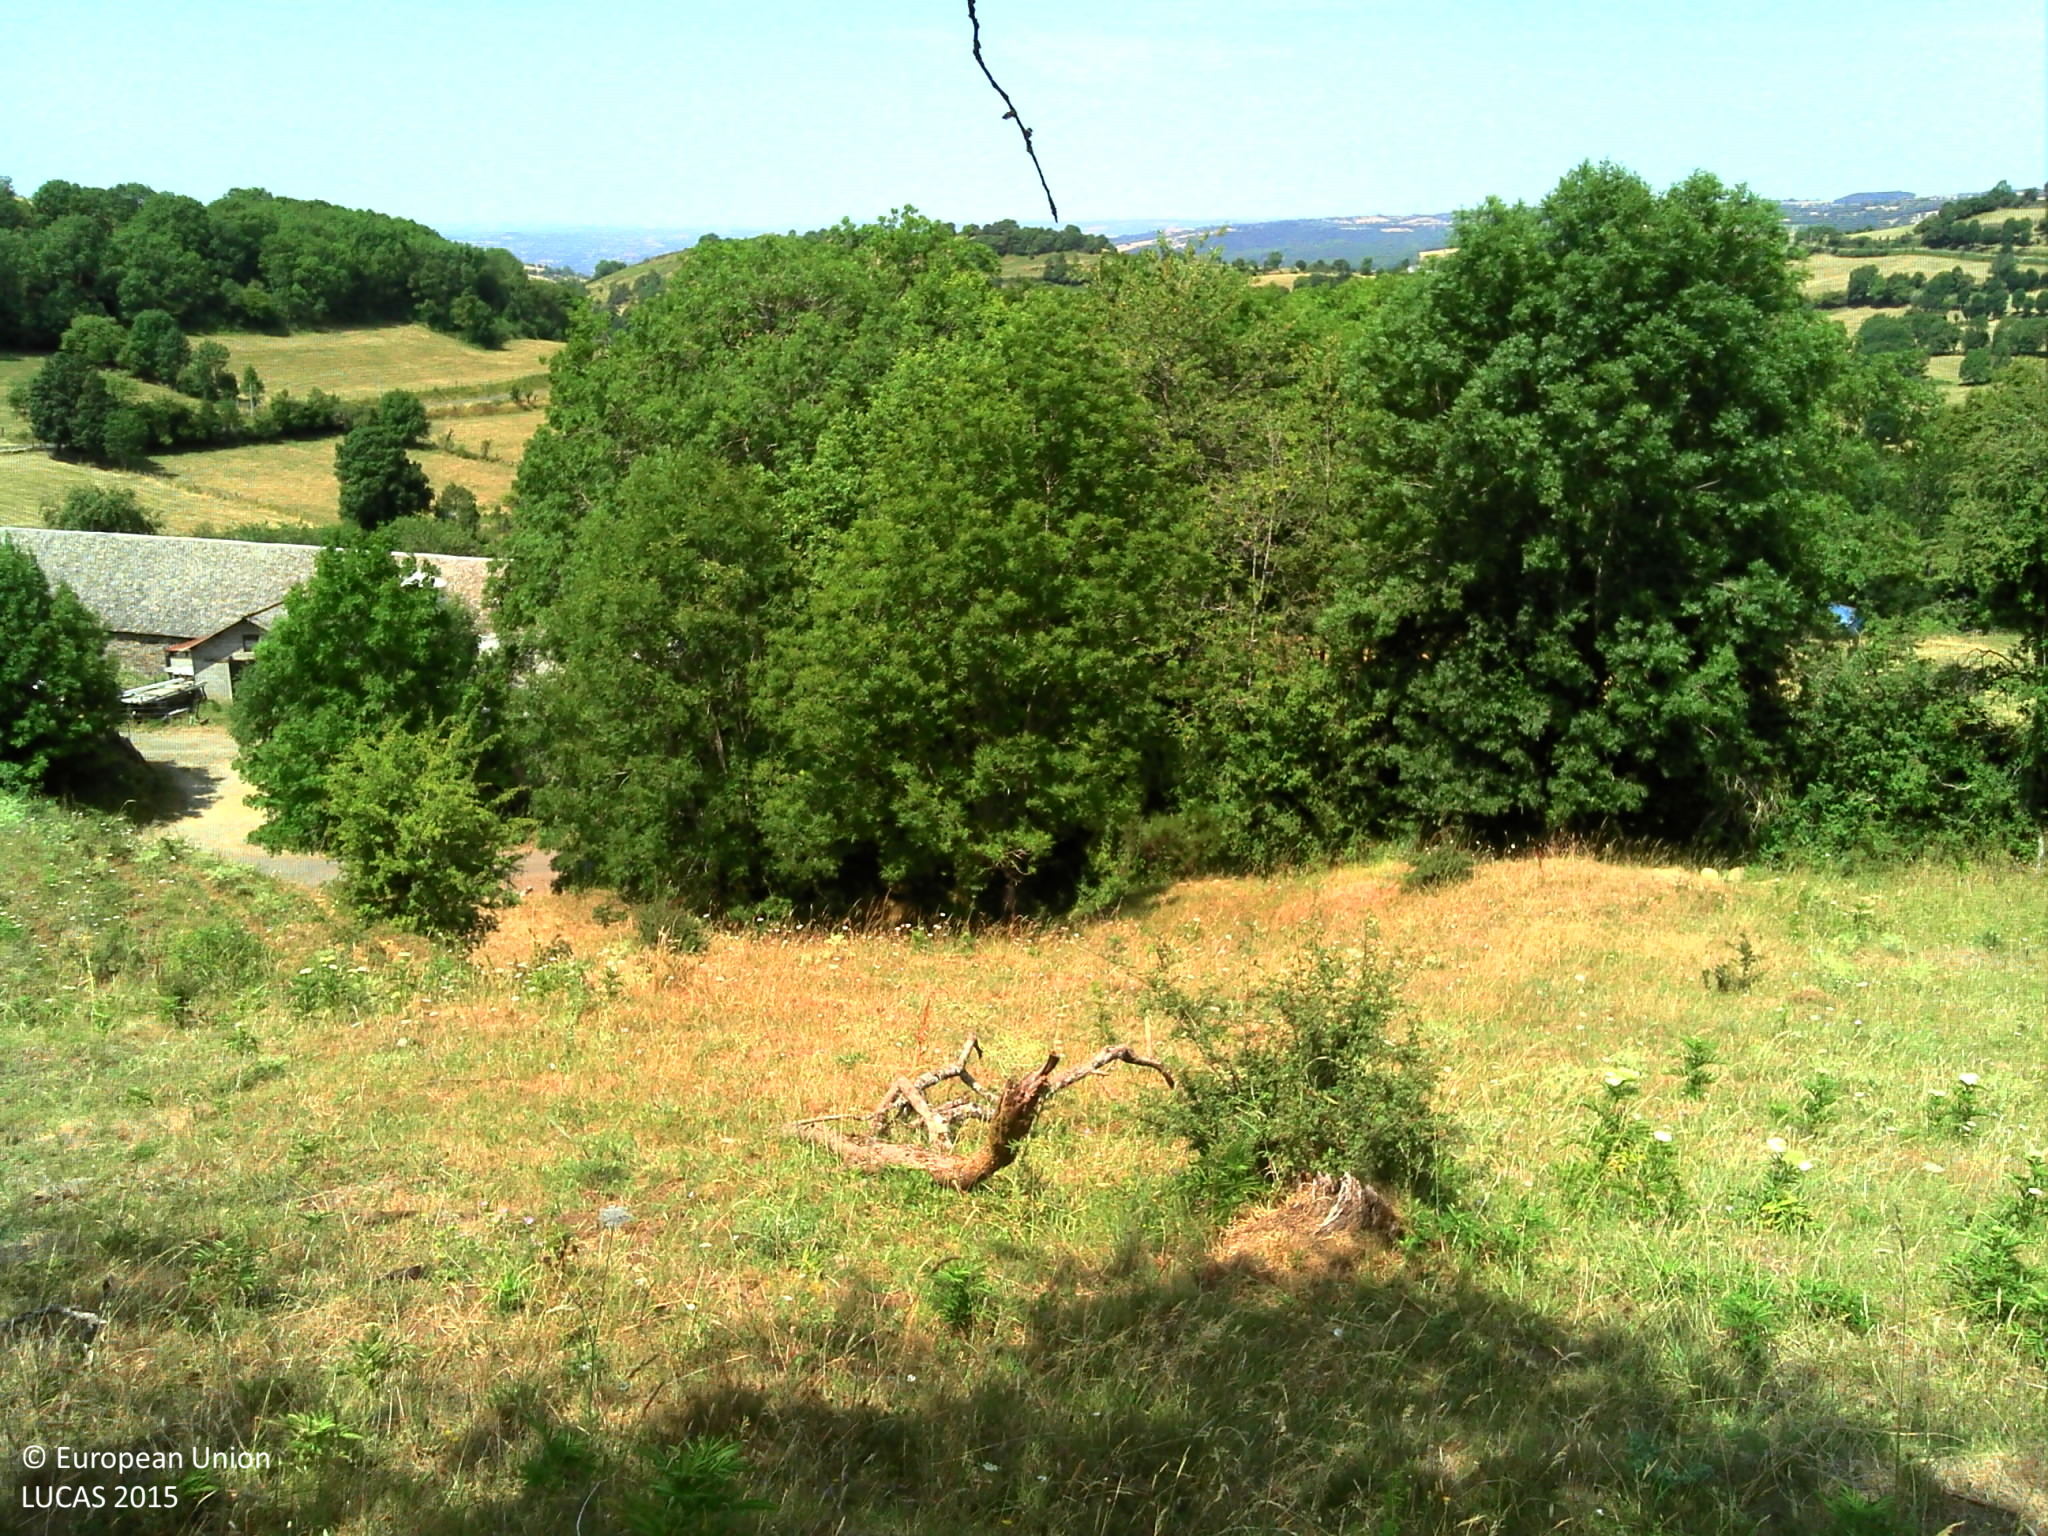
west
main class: Grassland
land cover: Grassland without tree/shrub cover
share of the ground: > 75 %
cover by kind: herbaceous plants 100 %
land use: Agriculture (excluding fallow land and kitchen gardens)
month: July
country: FR
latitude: 44.5265
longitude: 2.9449
